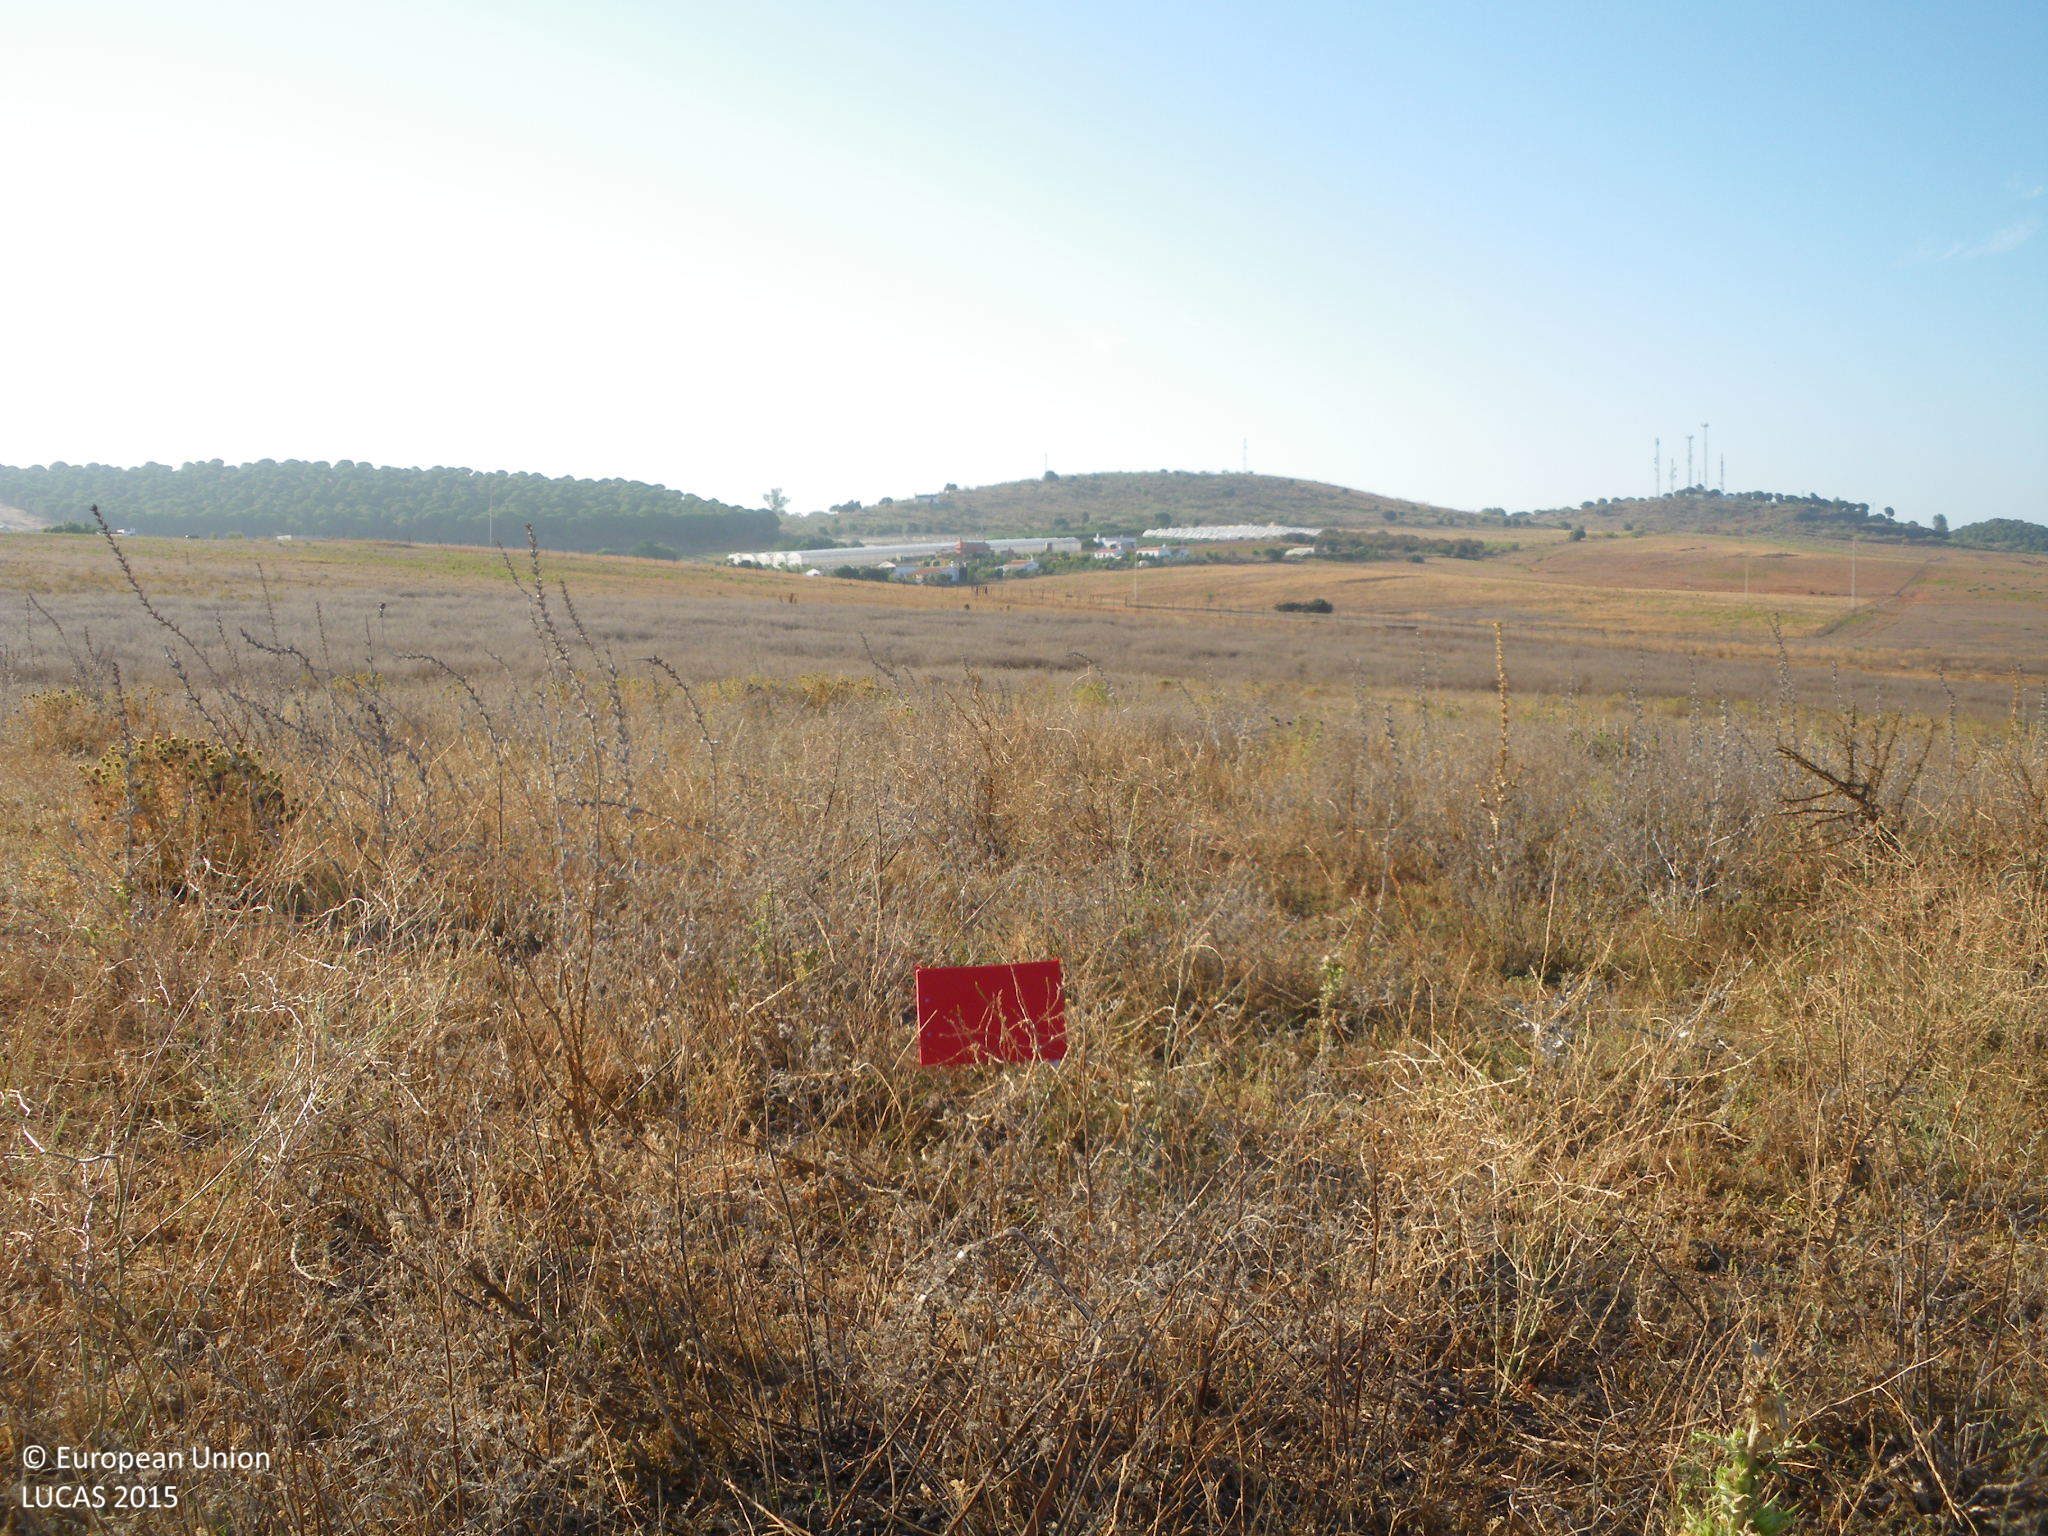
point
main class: Grassland
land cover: Grassland without tree/shrub cover
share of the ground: > 75 %
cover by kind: herbaceous plants 95 %, unconsolidated bare surface 5 %
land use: Agriculture (excluding fallow land and kitchen gardens)
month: June
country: ES
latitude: 36.8296
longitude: -5.7622
